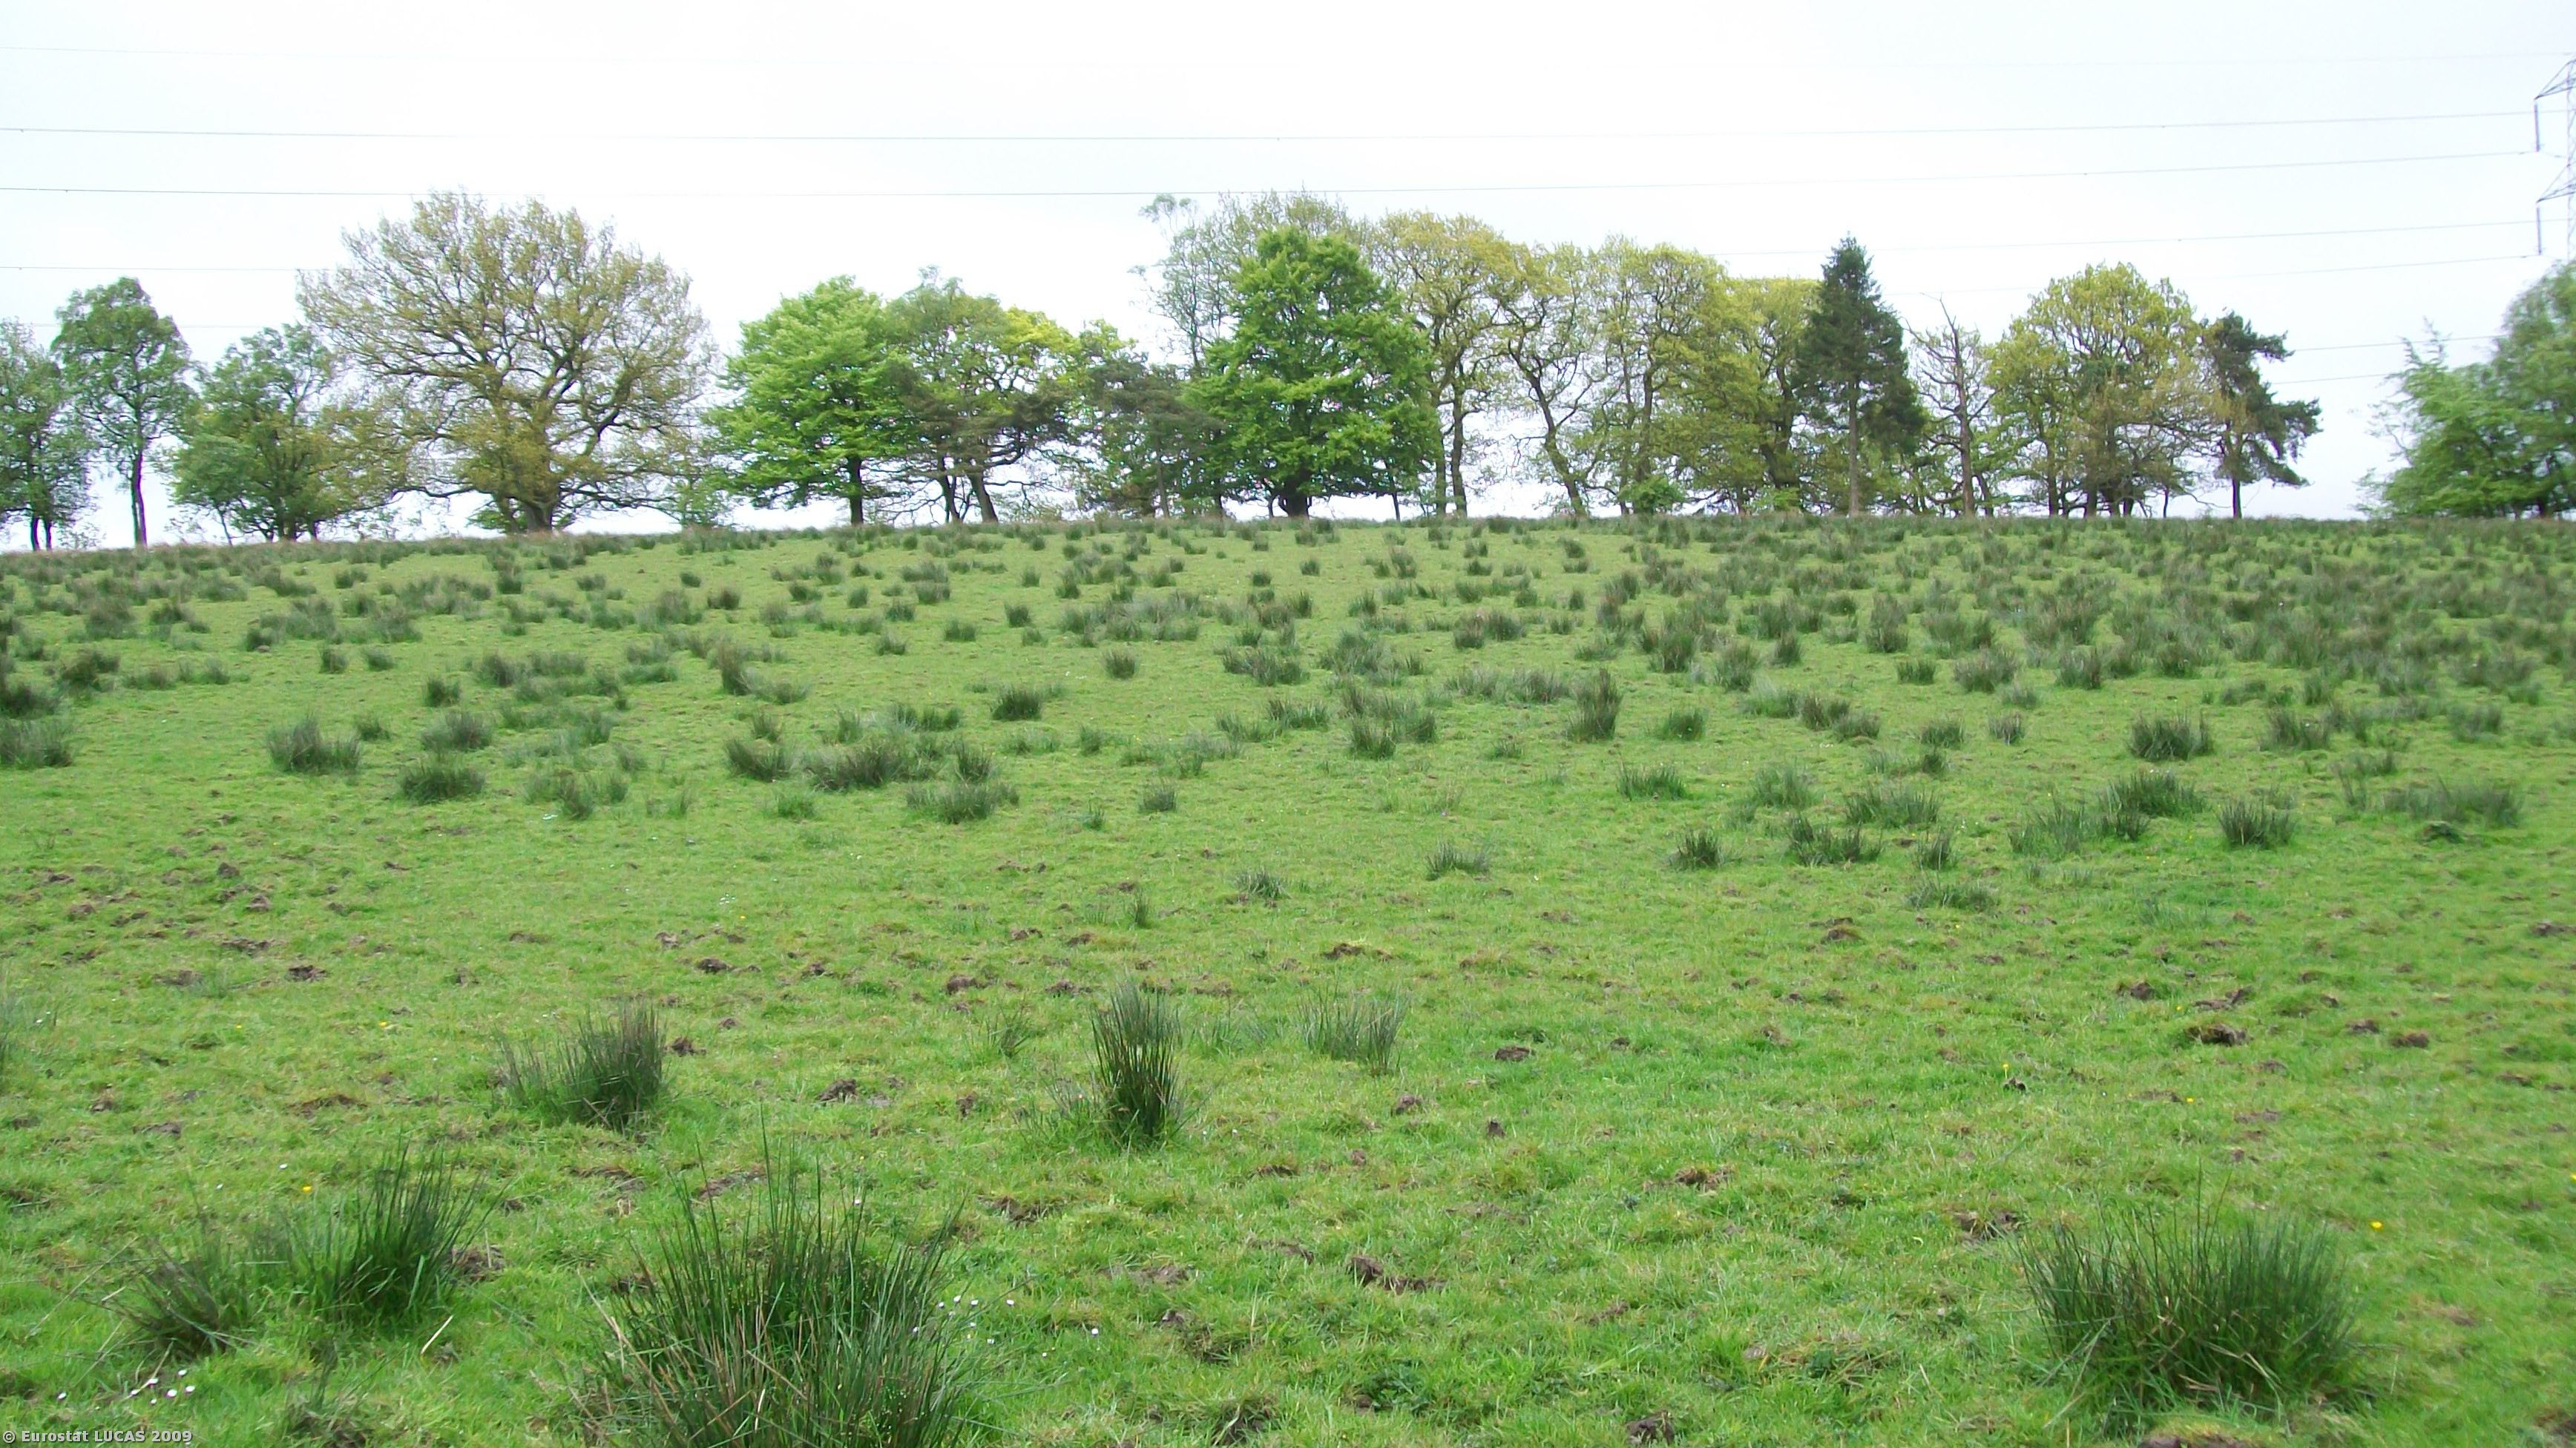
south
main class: Grassland
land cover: Grassland without tree/shrub cover
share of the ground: > 75 %
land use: Agriculture (excluding fallow land and kitchen gardens)
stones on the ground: < 10 %
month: May
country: GB
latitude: 55.8278
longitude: -3.5685
